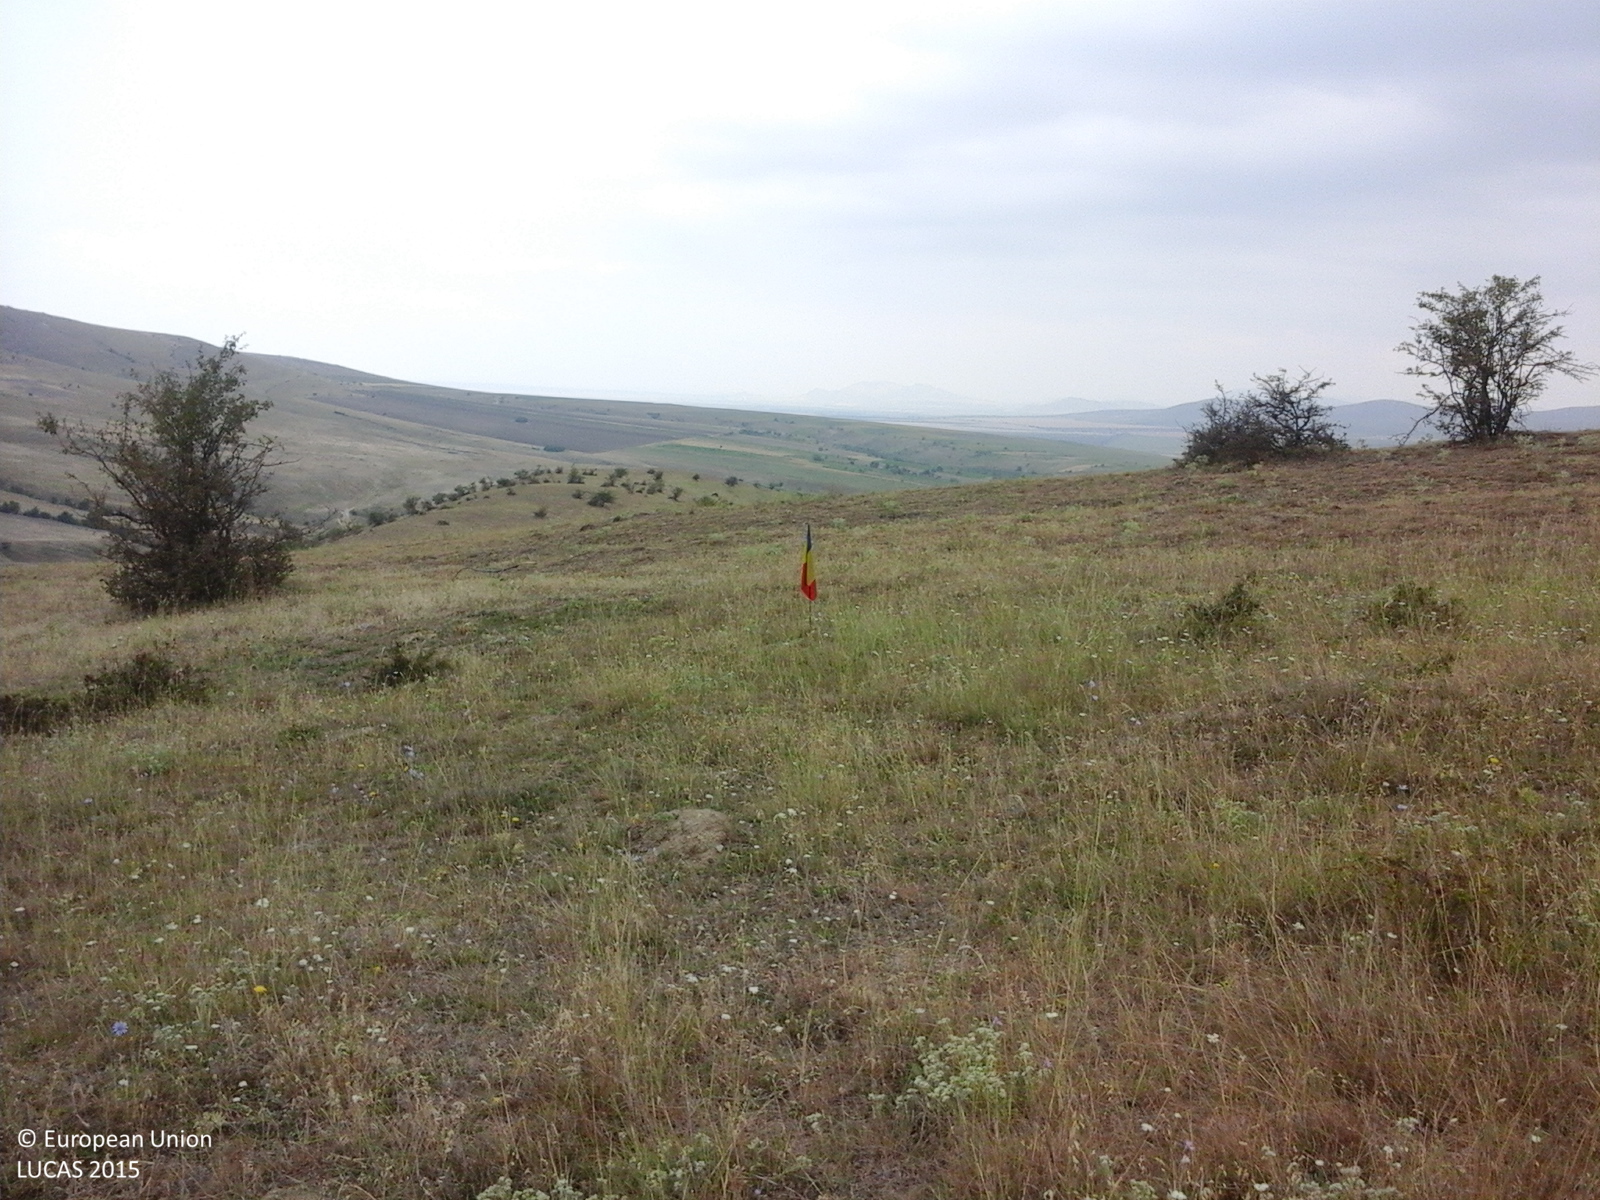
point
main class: Grassland
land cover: Grassland with sparse tree/shrub cover
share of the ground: > 75 %
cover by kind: herbaceous plants 95 %, broadleaved forest trees 5 %
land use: Agriculture (excluding fallow land and kitchen gardens)
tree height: < 5 m
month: July
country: RO
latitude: 44.9425
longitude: 28.2818
